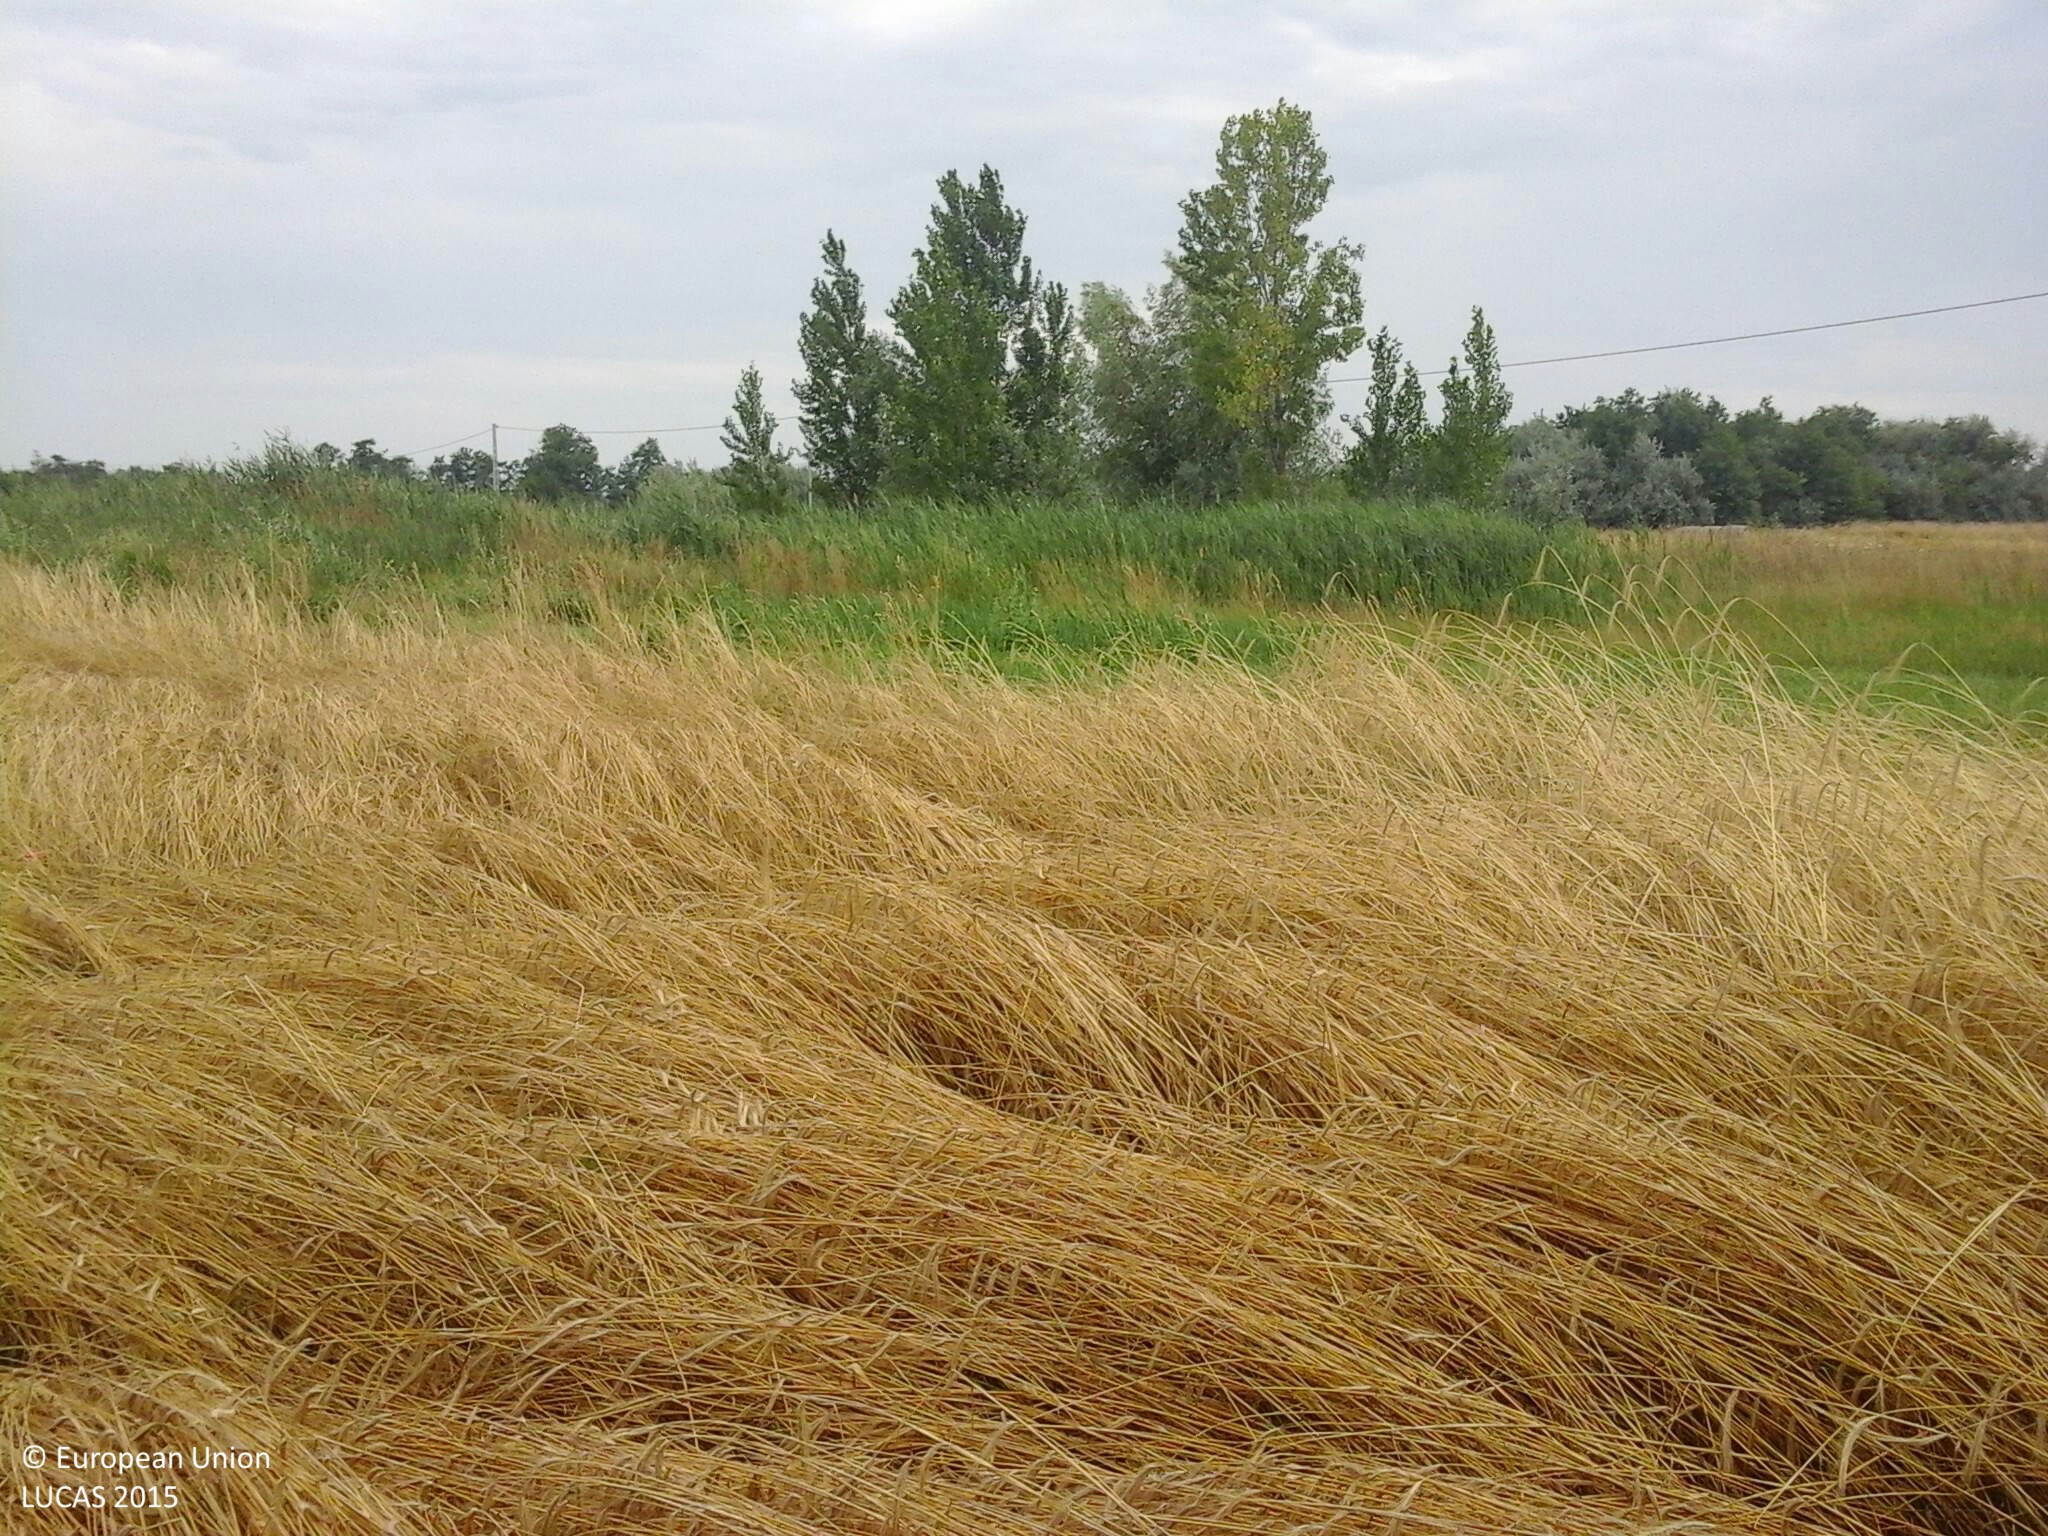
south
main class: Cropland
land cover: Triticale
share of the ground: > 75 %
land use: Agriculture (excluding fallow land and kitchen gardens)
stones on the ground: < 10 %
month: July
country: HU
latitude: 46.4409
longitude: 20.0312
